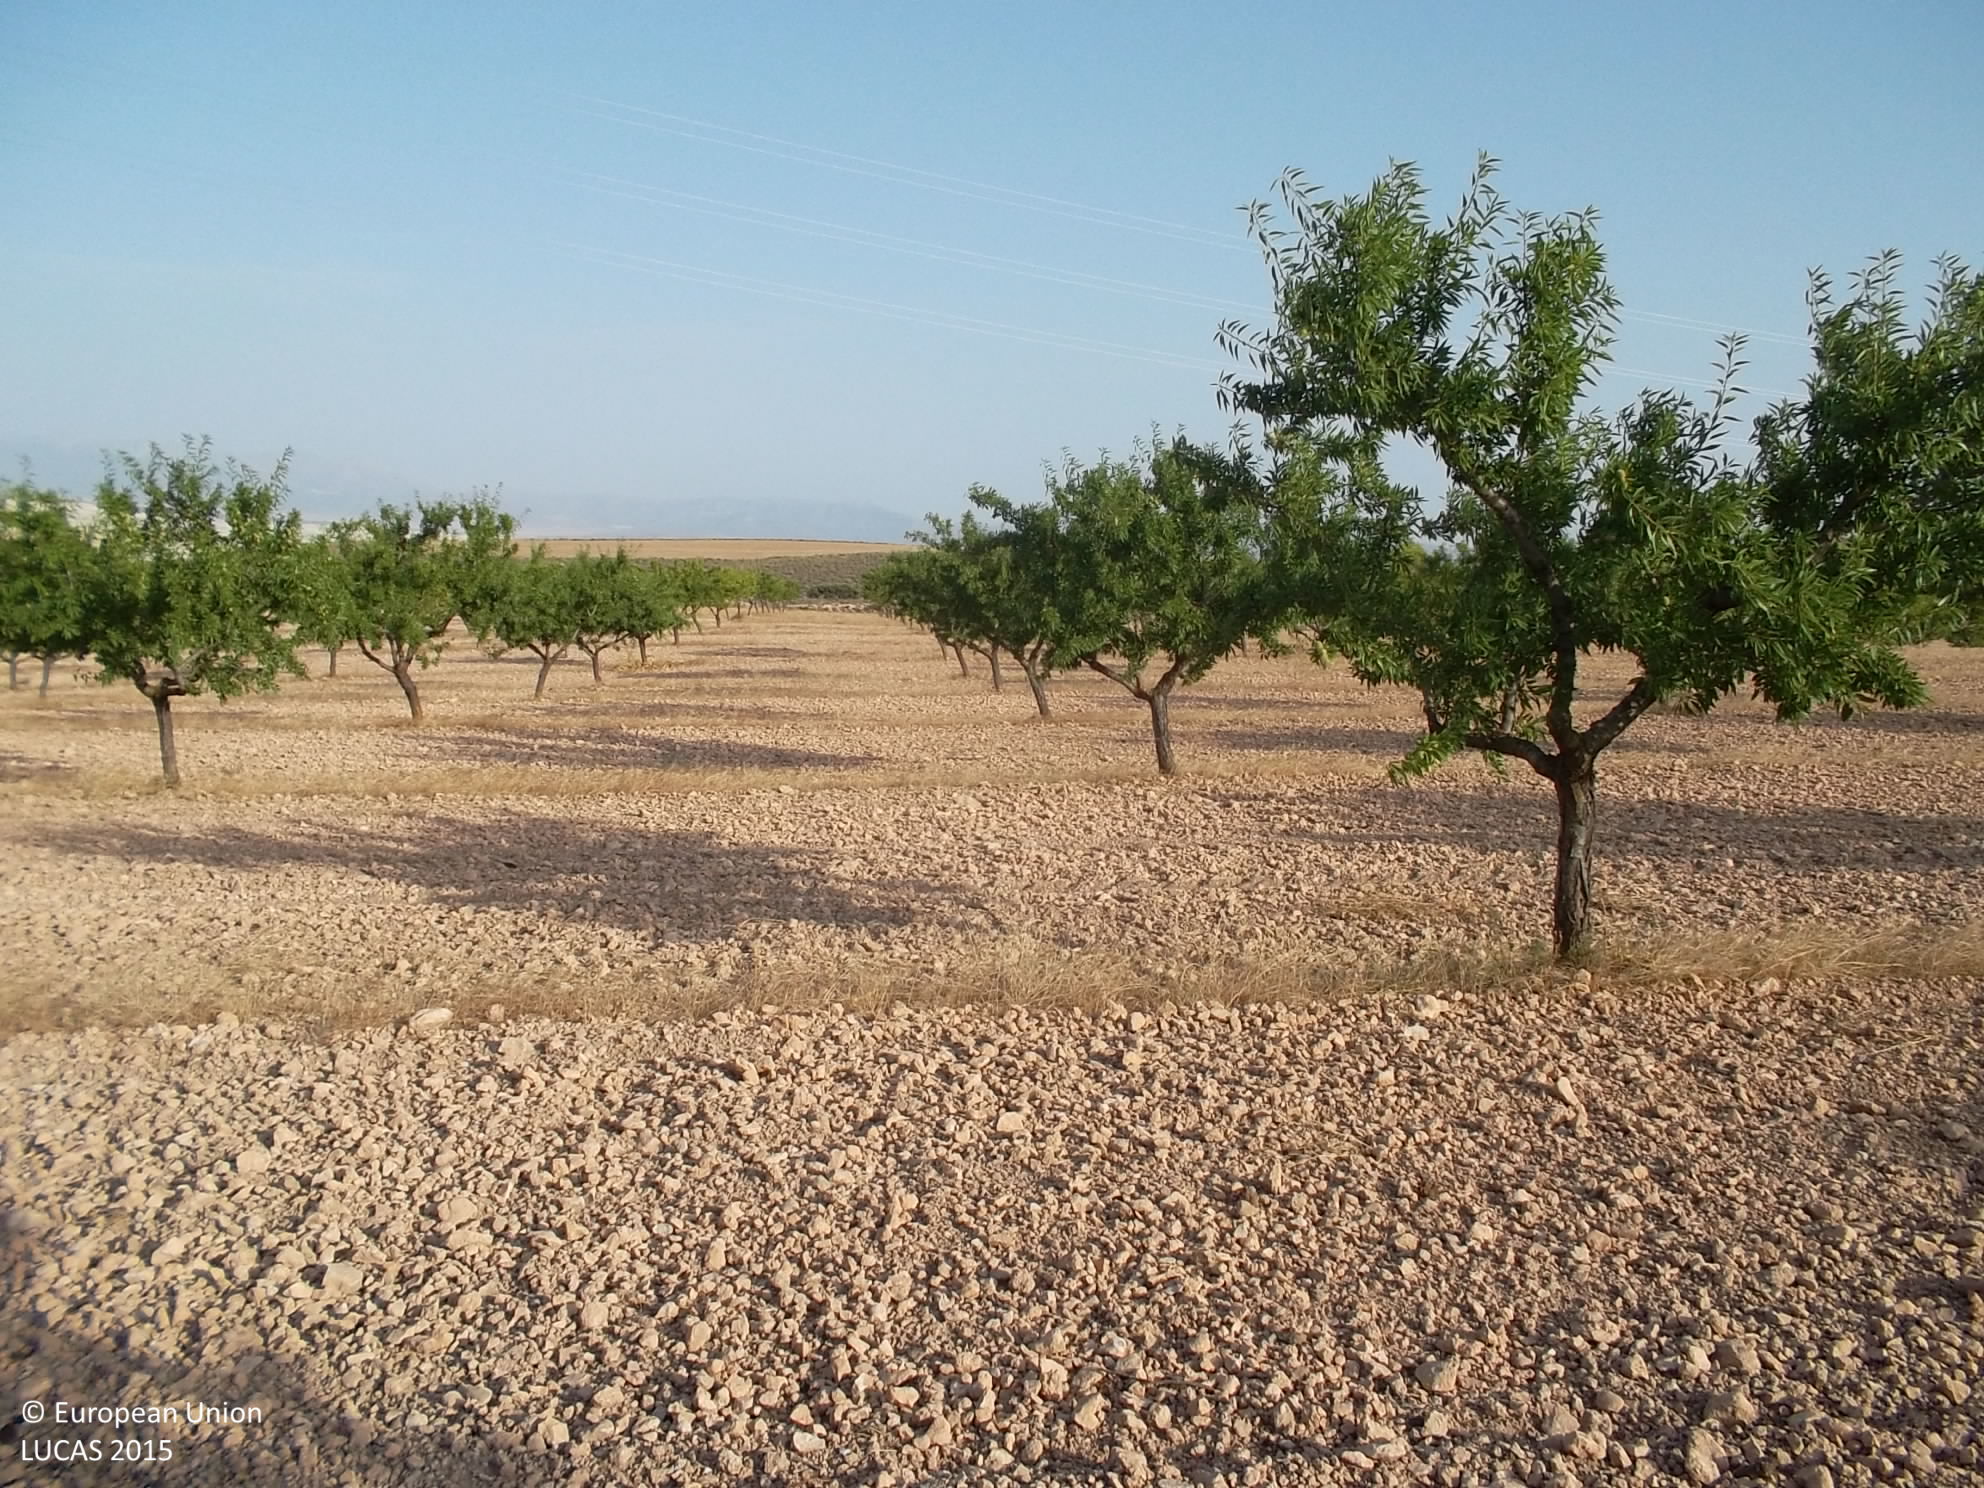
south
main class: Cropland
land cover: Nuts trees
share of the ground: 25 - 50 %
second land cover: Other bare soil
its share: > 75 %
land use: Agriculture (excluding fallow land and kitchen gardens)
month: July
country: ES
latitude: 37.8206
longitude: -2.4745
